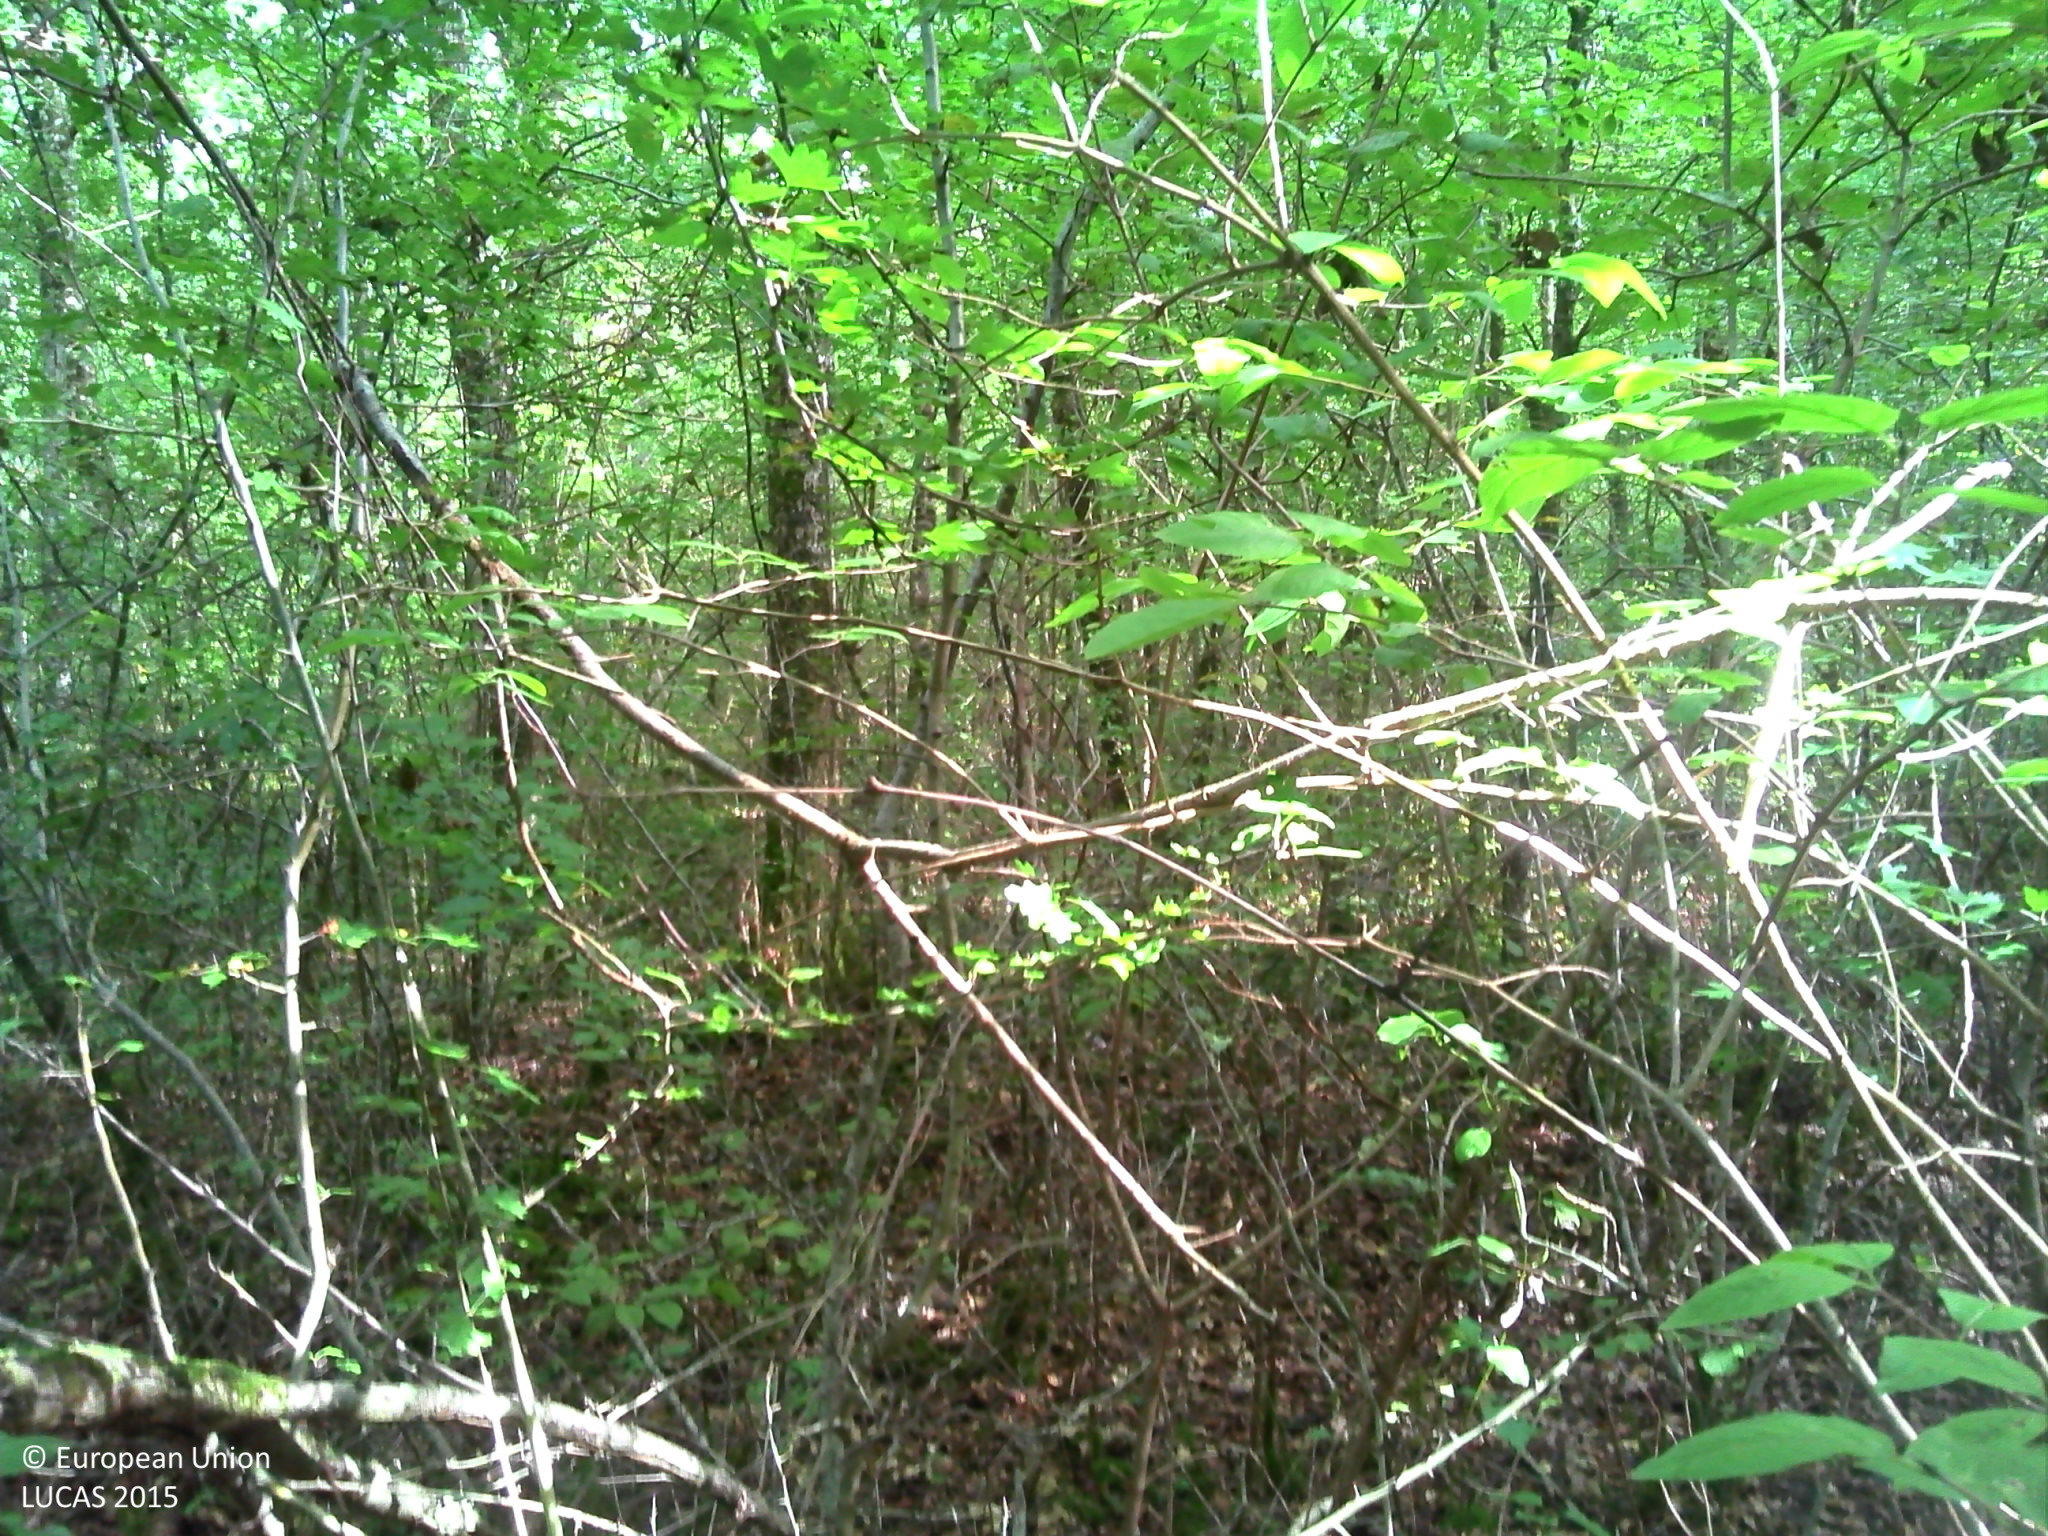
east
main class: Woodland
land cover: Broadleaved woodland
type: mesophytic deciduous forest
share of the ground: > 75 %
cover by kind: broadleaved forest trees 80 %, shrubs 10 %, herbaceous plants 10 %
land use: Forestry
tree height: > 5 m
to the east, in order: Broadleaved woodland; Fences; Broadleaved woodland; Tracks; Broadleaved woodland; Rape and turnip rape
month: September
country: FR
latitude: 48.2580
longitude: 2.7850
